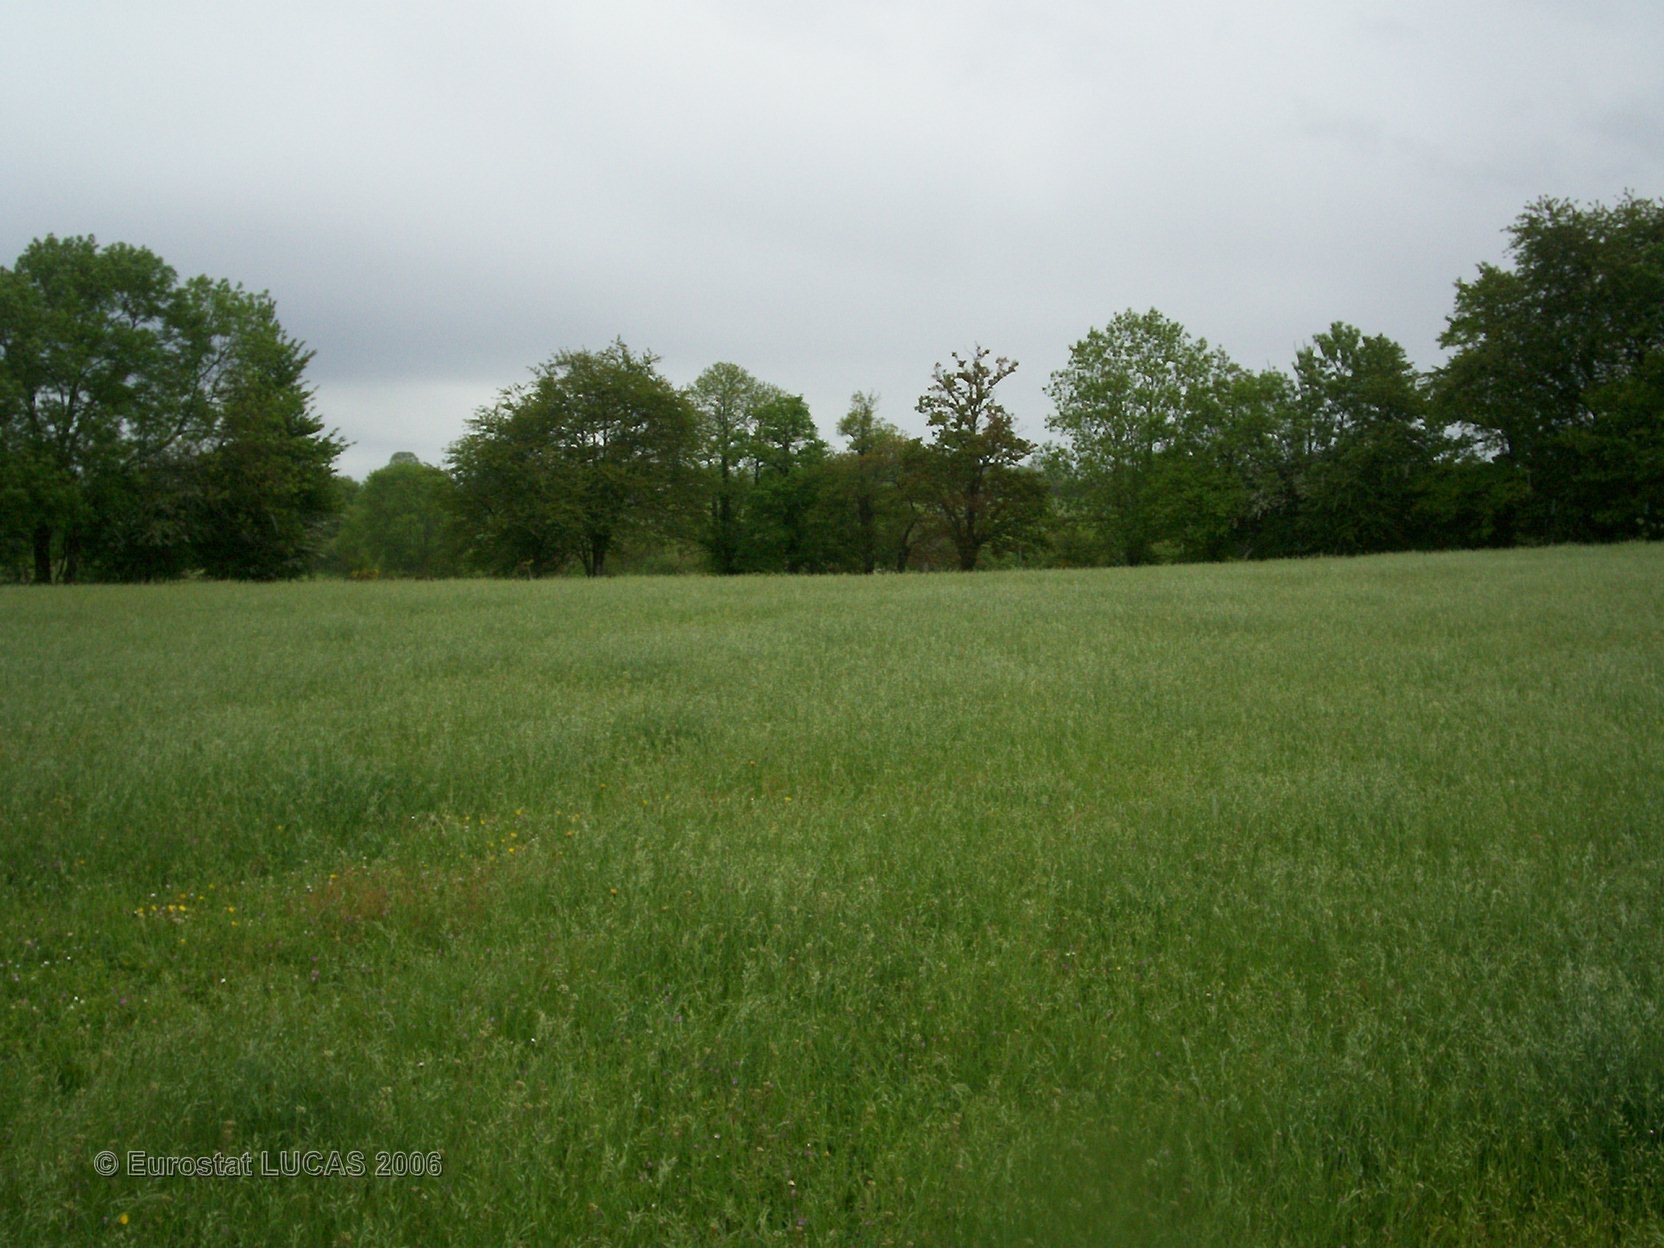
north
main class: Grassland
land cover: Grassland without tree/shrub cover
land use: Agriculture (excluding fallow land and kitchen gardens)
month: May
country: FR
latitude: 46.6301
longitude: -0.3309
